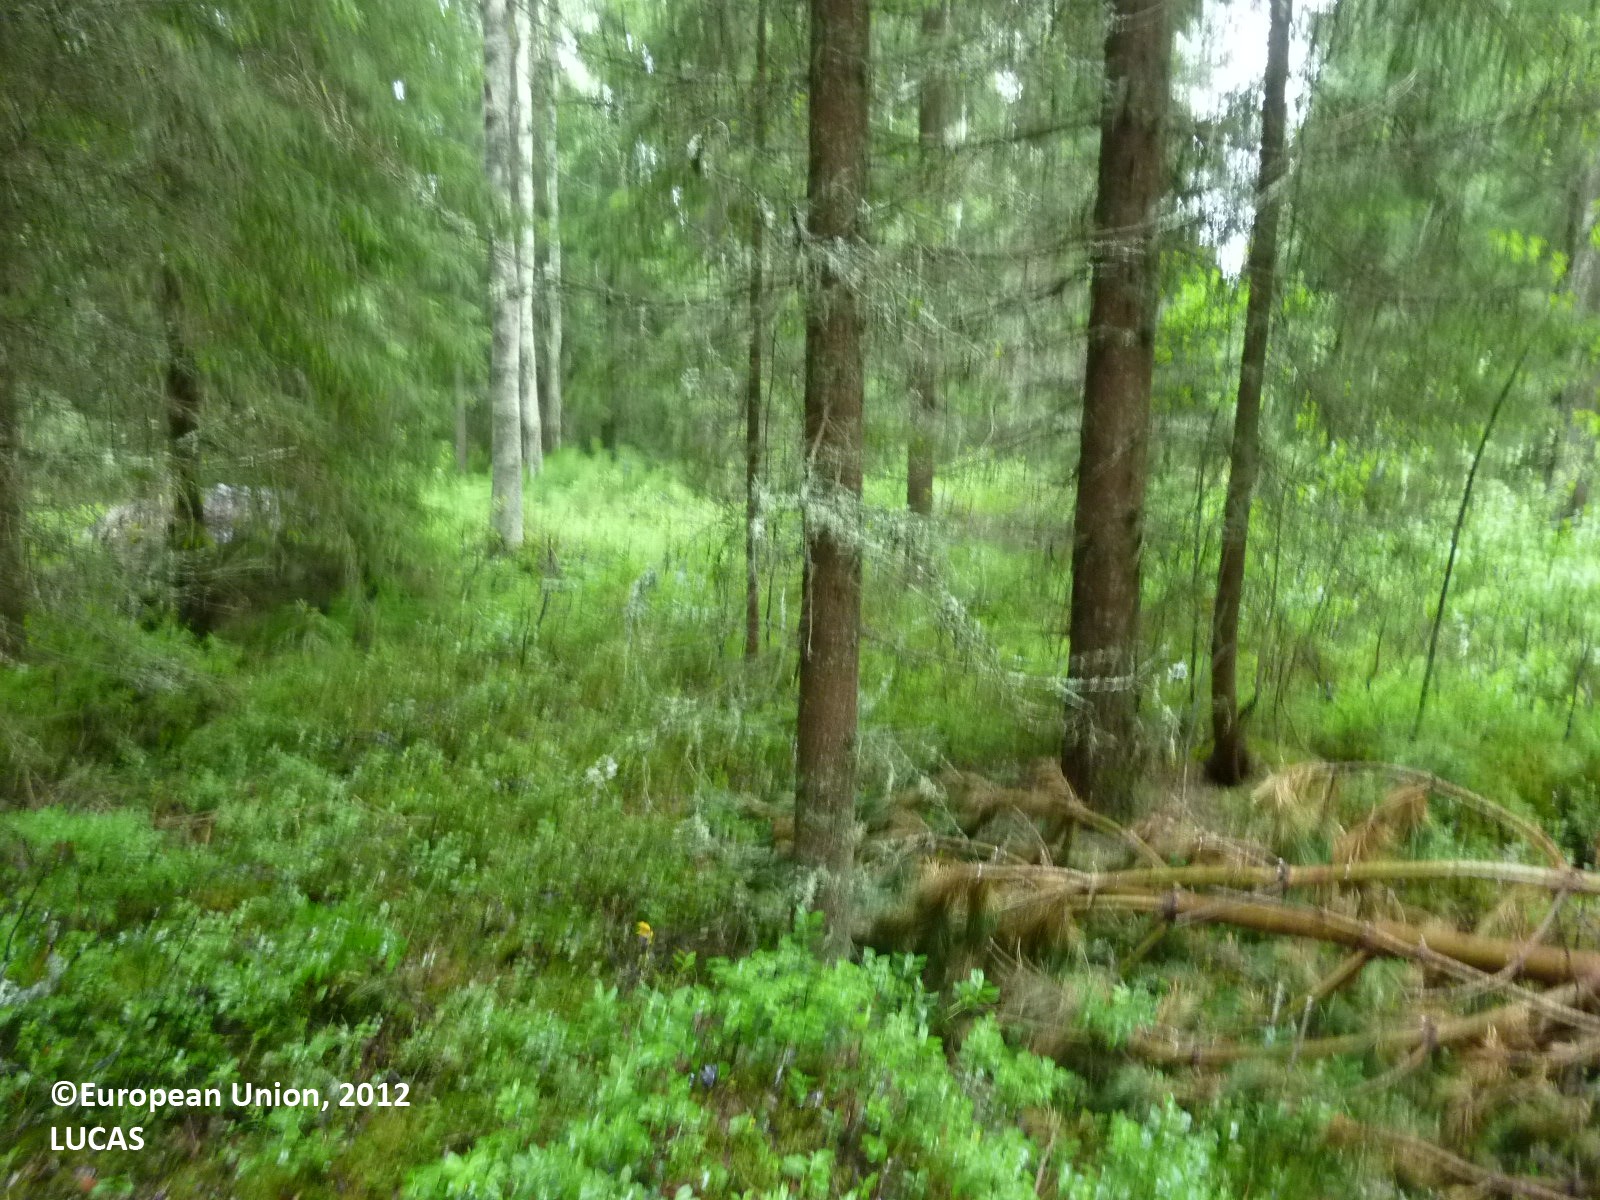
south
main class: Woodland
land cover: Spruce dominated coniferous woodland
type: boreal forest
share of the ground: > 75 %
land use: Forestry
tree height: > 5 m
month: July
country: FI
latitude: 61.4502
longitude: 22.2712
